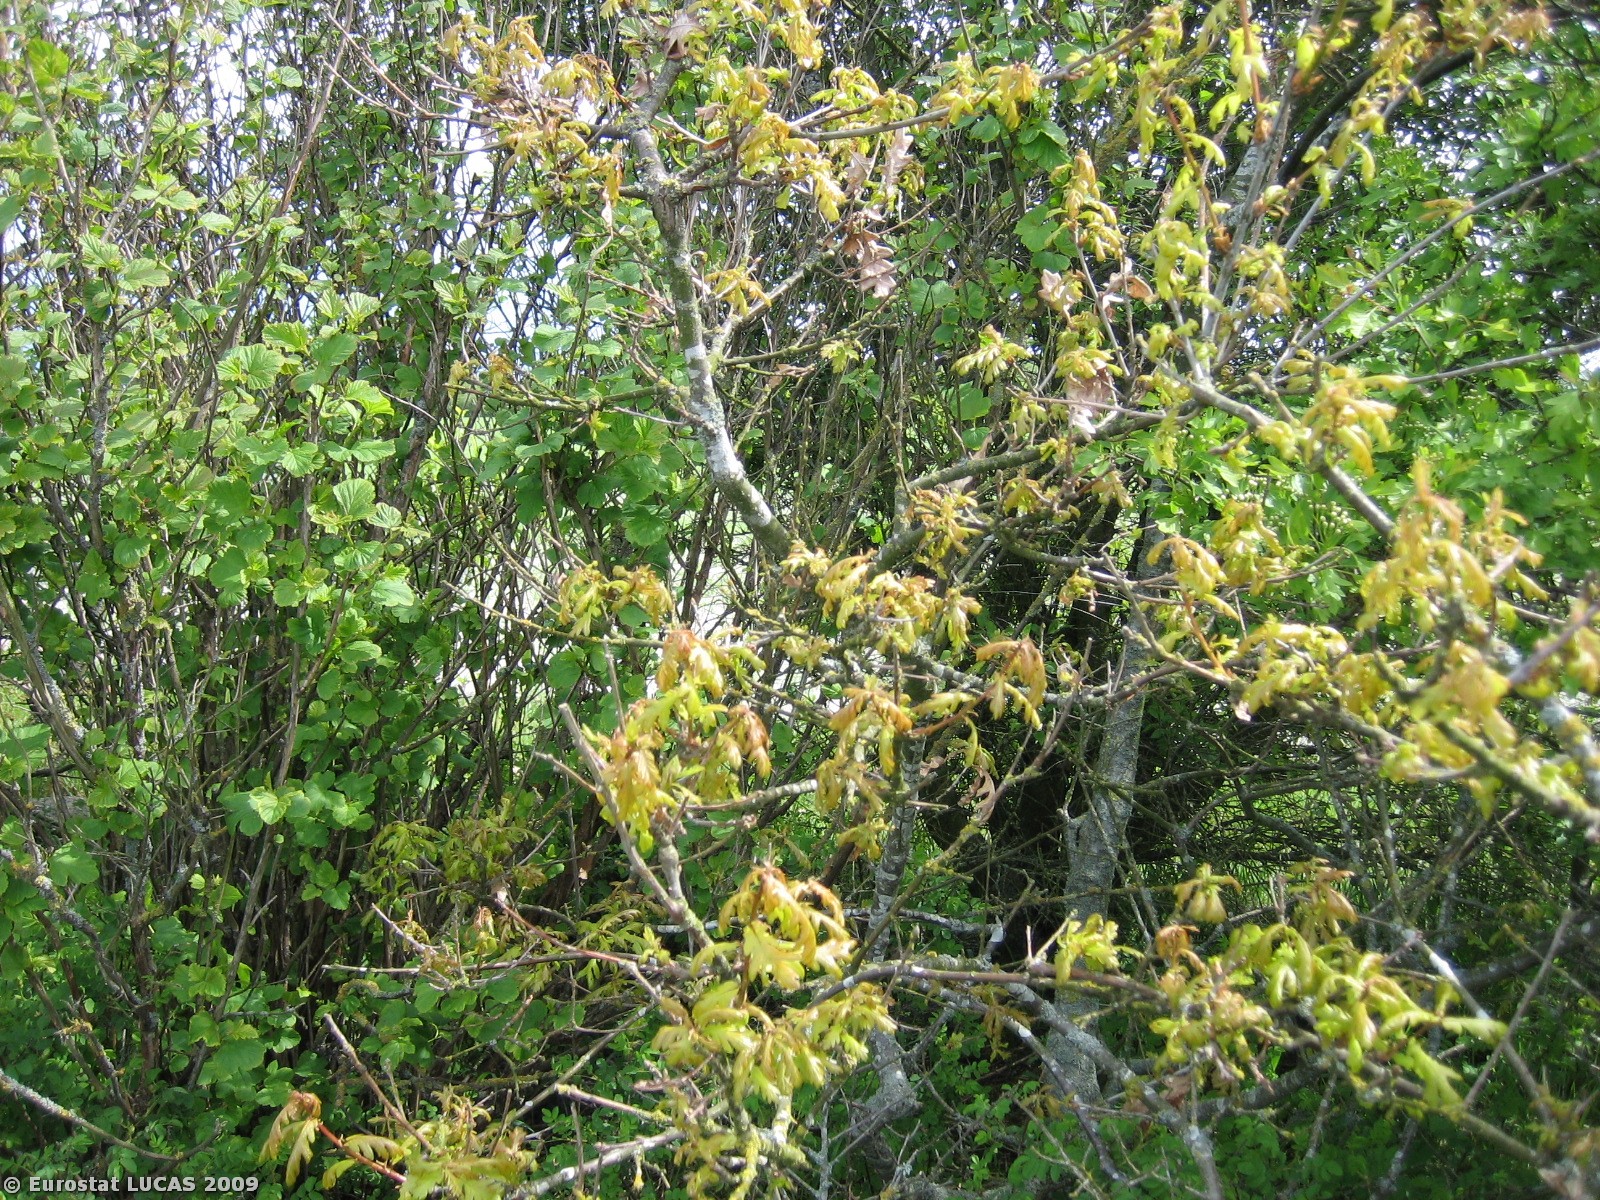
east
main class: Shrubland
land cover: Shrubland with sparse tree cover
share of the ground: > 75 %
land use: Unused
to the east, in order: Shrubland with sparse tree cover; Grass margins; Rye; Broadleaved woodland; Common wheat; Grass margins; Tracks; Broadleaved woodland; Maize
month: May
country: DK
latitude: 56.1958
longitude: 8.4062
